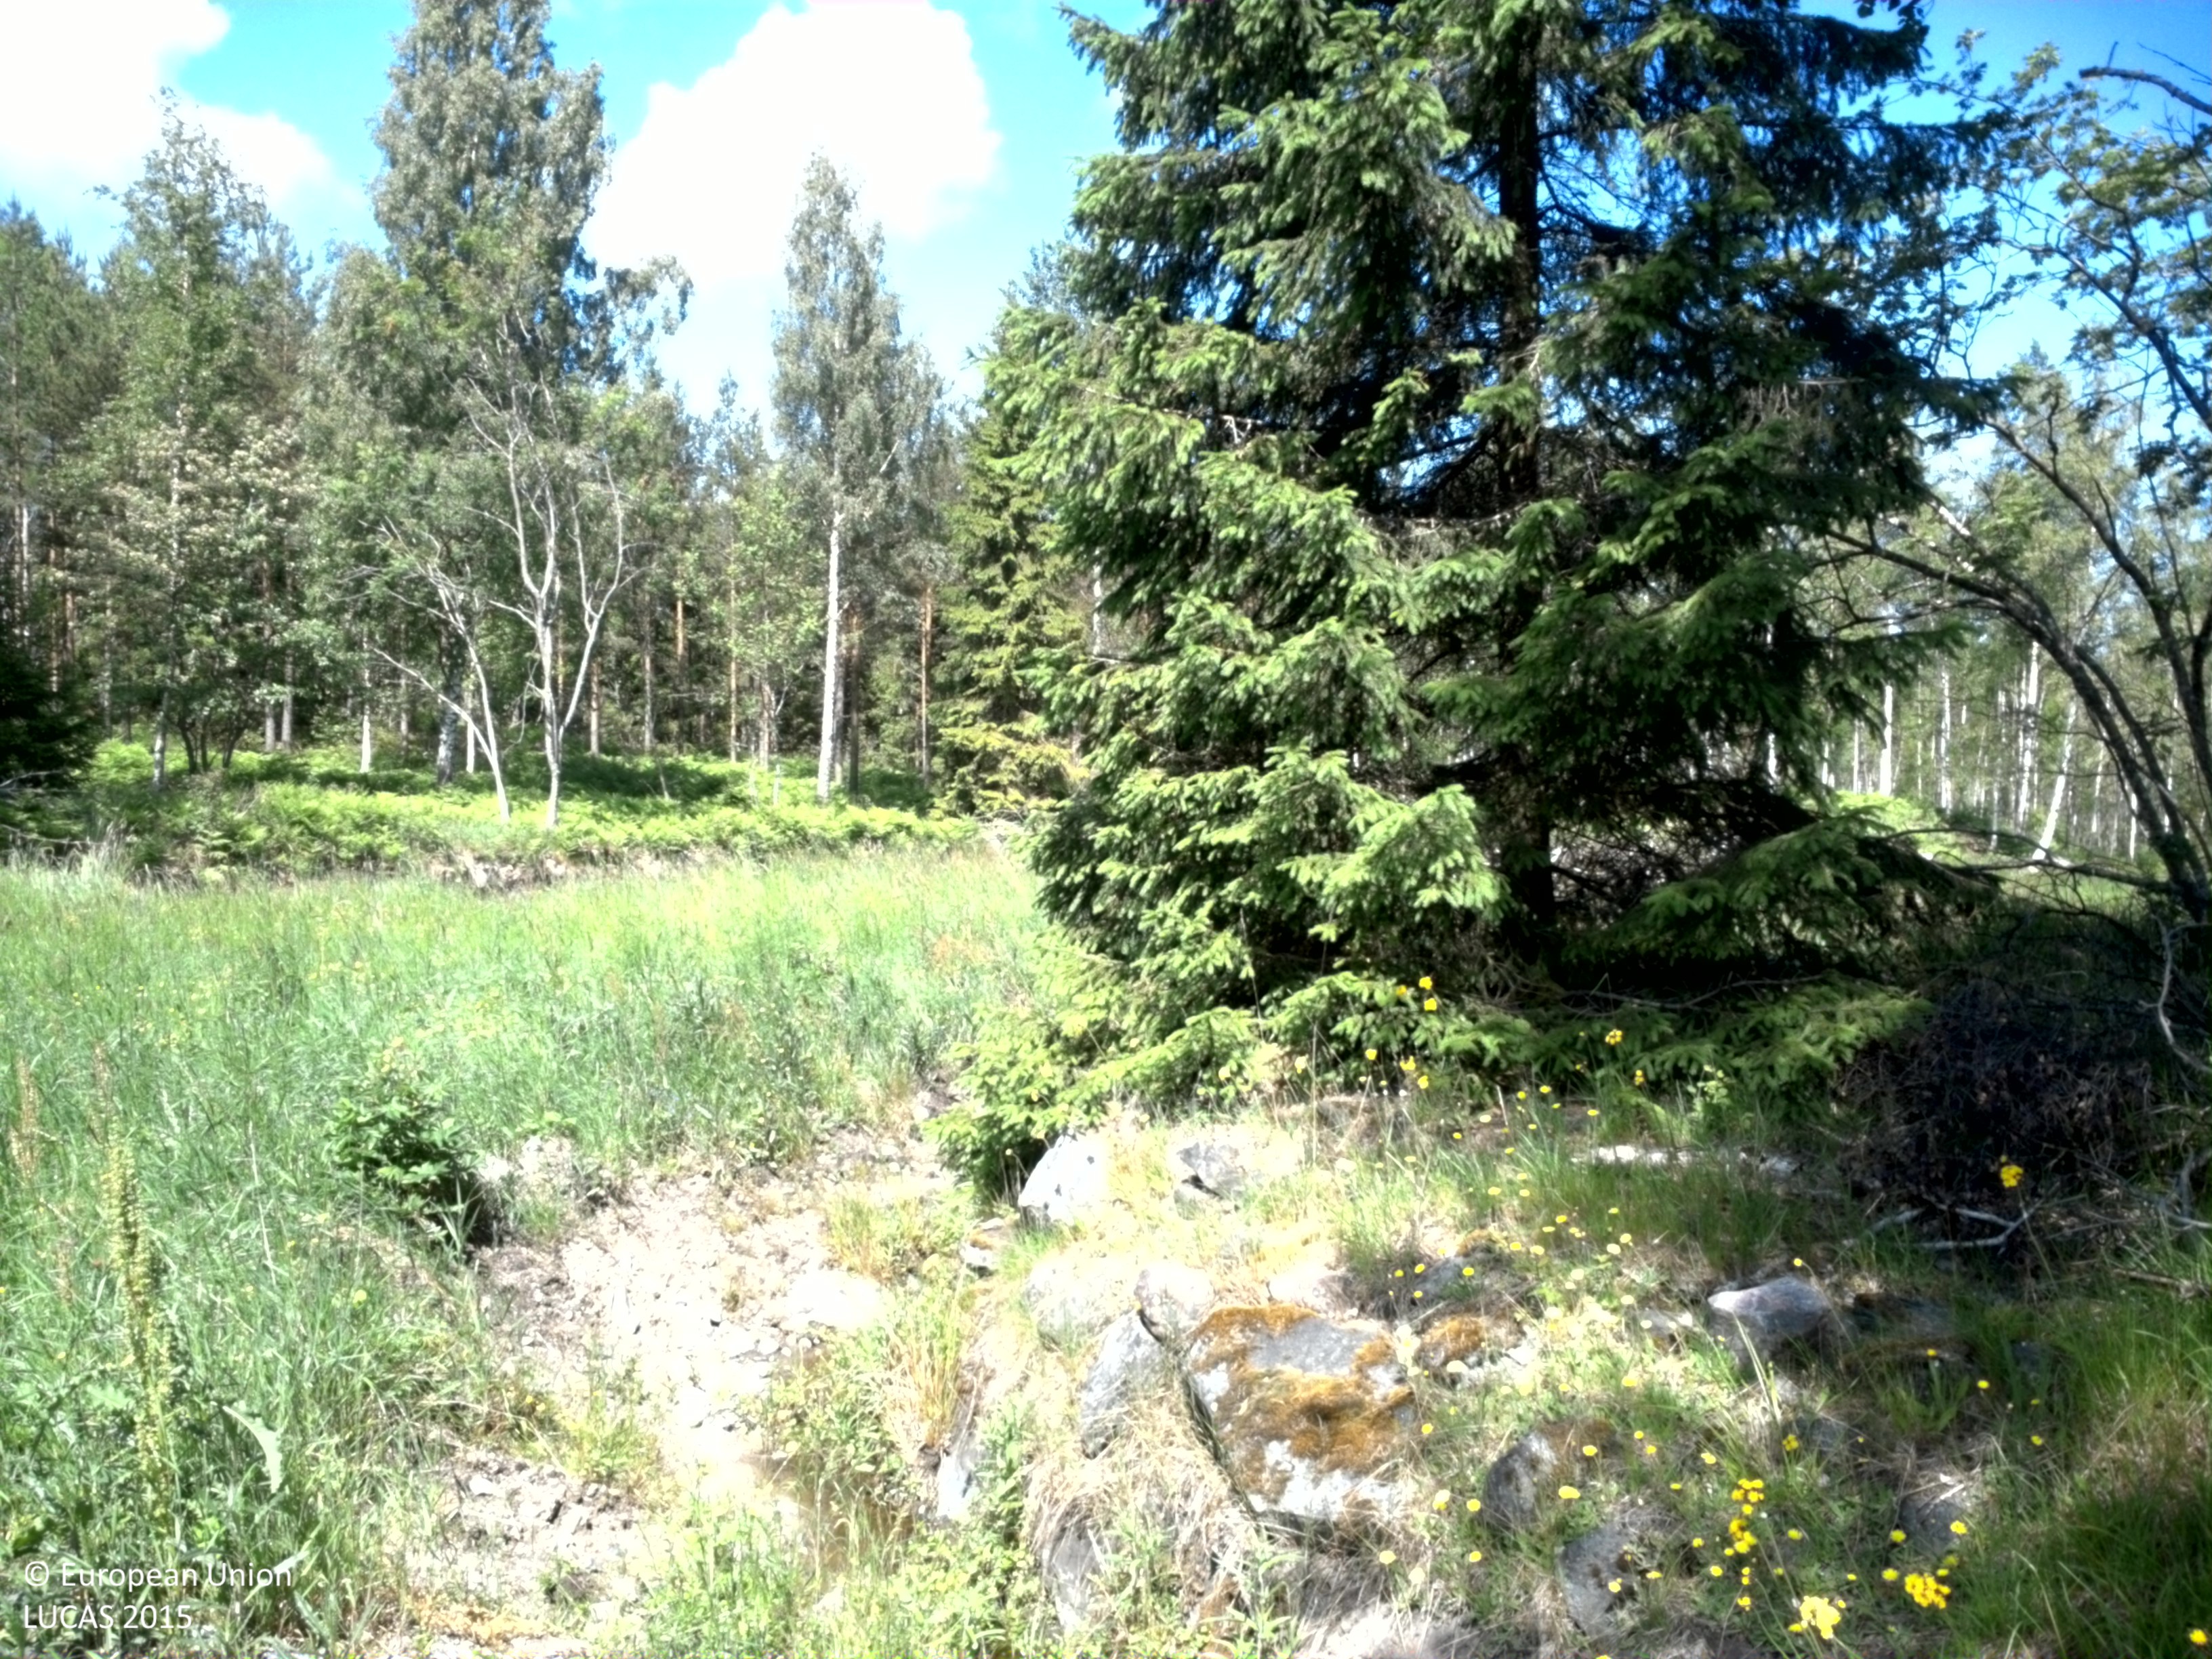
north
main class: Grassland
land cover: Grassland without tree/shrub cover
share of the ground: 25 - 50 %
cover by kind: unconsolidated bare surface 60 %, herbaceous plants 40 %
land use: Semi-natural and natural areas not in use
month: June
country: SE
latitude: 60.0983
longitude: 18.6118
